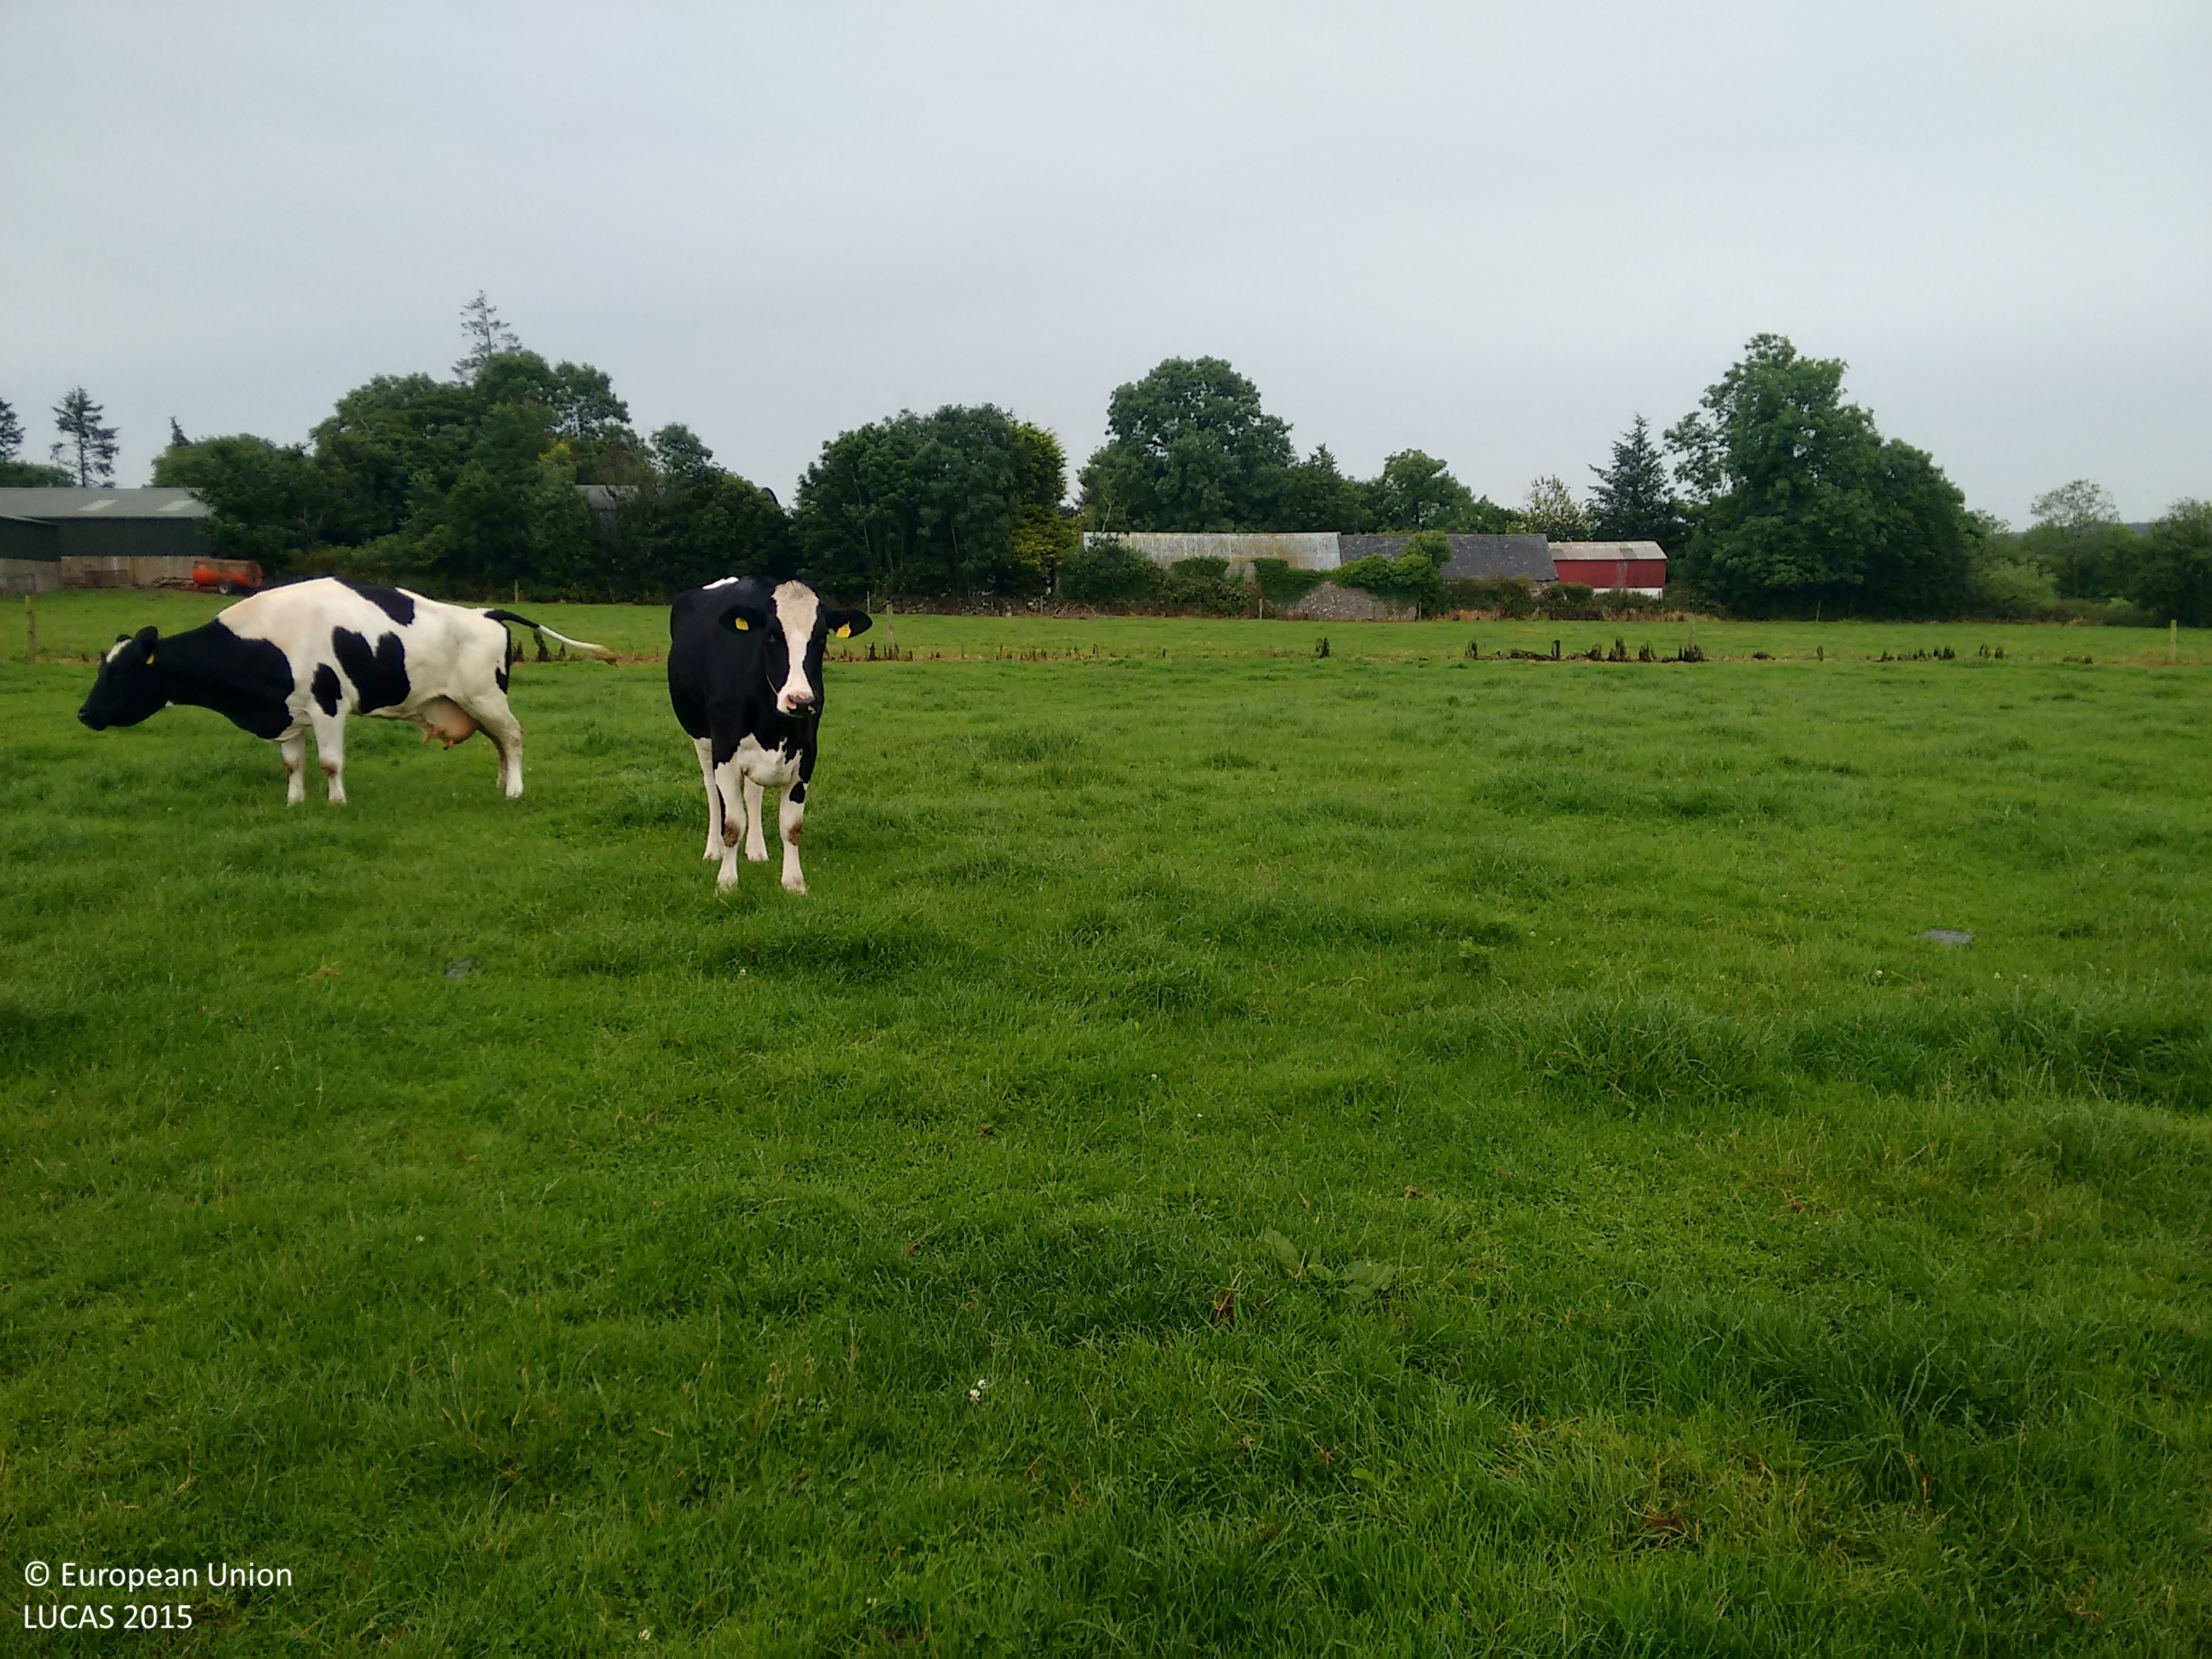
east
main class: Grassland
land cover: Grassland without tree/shrub cover
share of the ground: > 75 %
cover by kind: herbaceous plants 100 %
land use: Agriculture (excluding fallow land and kitchen gardens)
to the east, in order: Grassland without tree/shrub cover; Fences; Grassland without tree/shrub cover; Fences; Grass margins; Artificial constructions in urban areas; Grassland with sparse tree/shrub cover; Abandoned hedges; Dry stone walls; Ditches and canals; Fences; Grass margins; Tracks; Grass margins; Fences; Grassland without tree/shrub cover; Fences; Grass margins; Tracks; Grass margins; Fences; Ditches and canals; Abandoned hedges; Fences; Grassland without tree/shrub cover
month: July
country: IE
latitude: 52.4382
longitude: -7.1679
